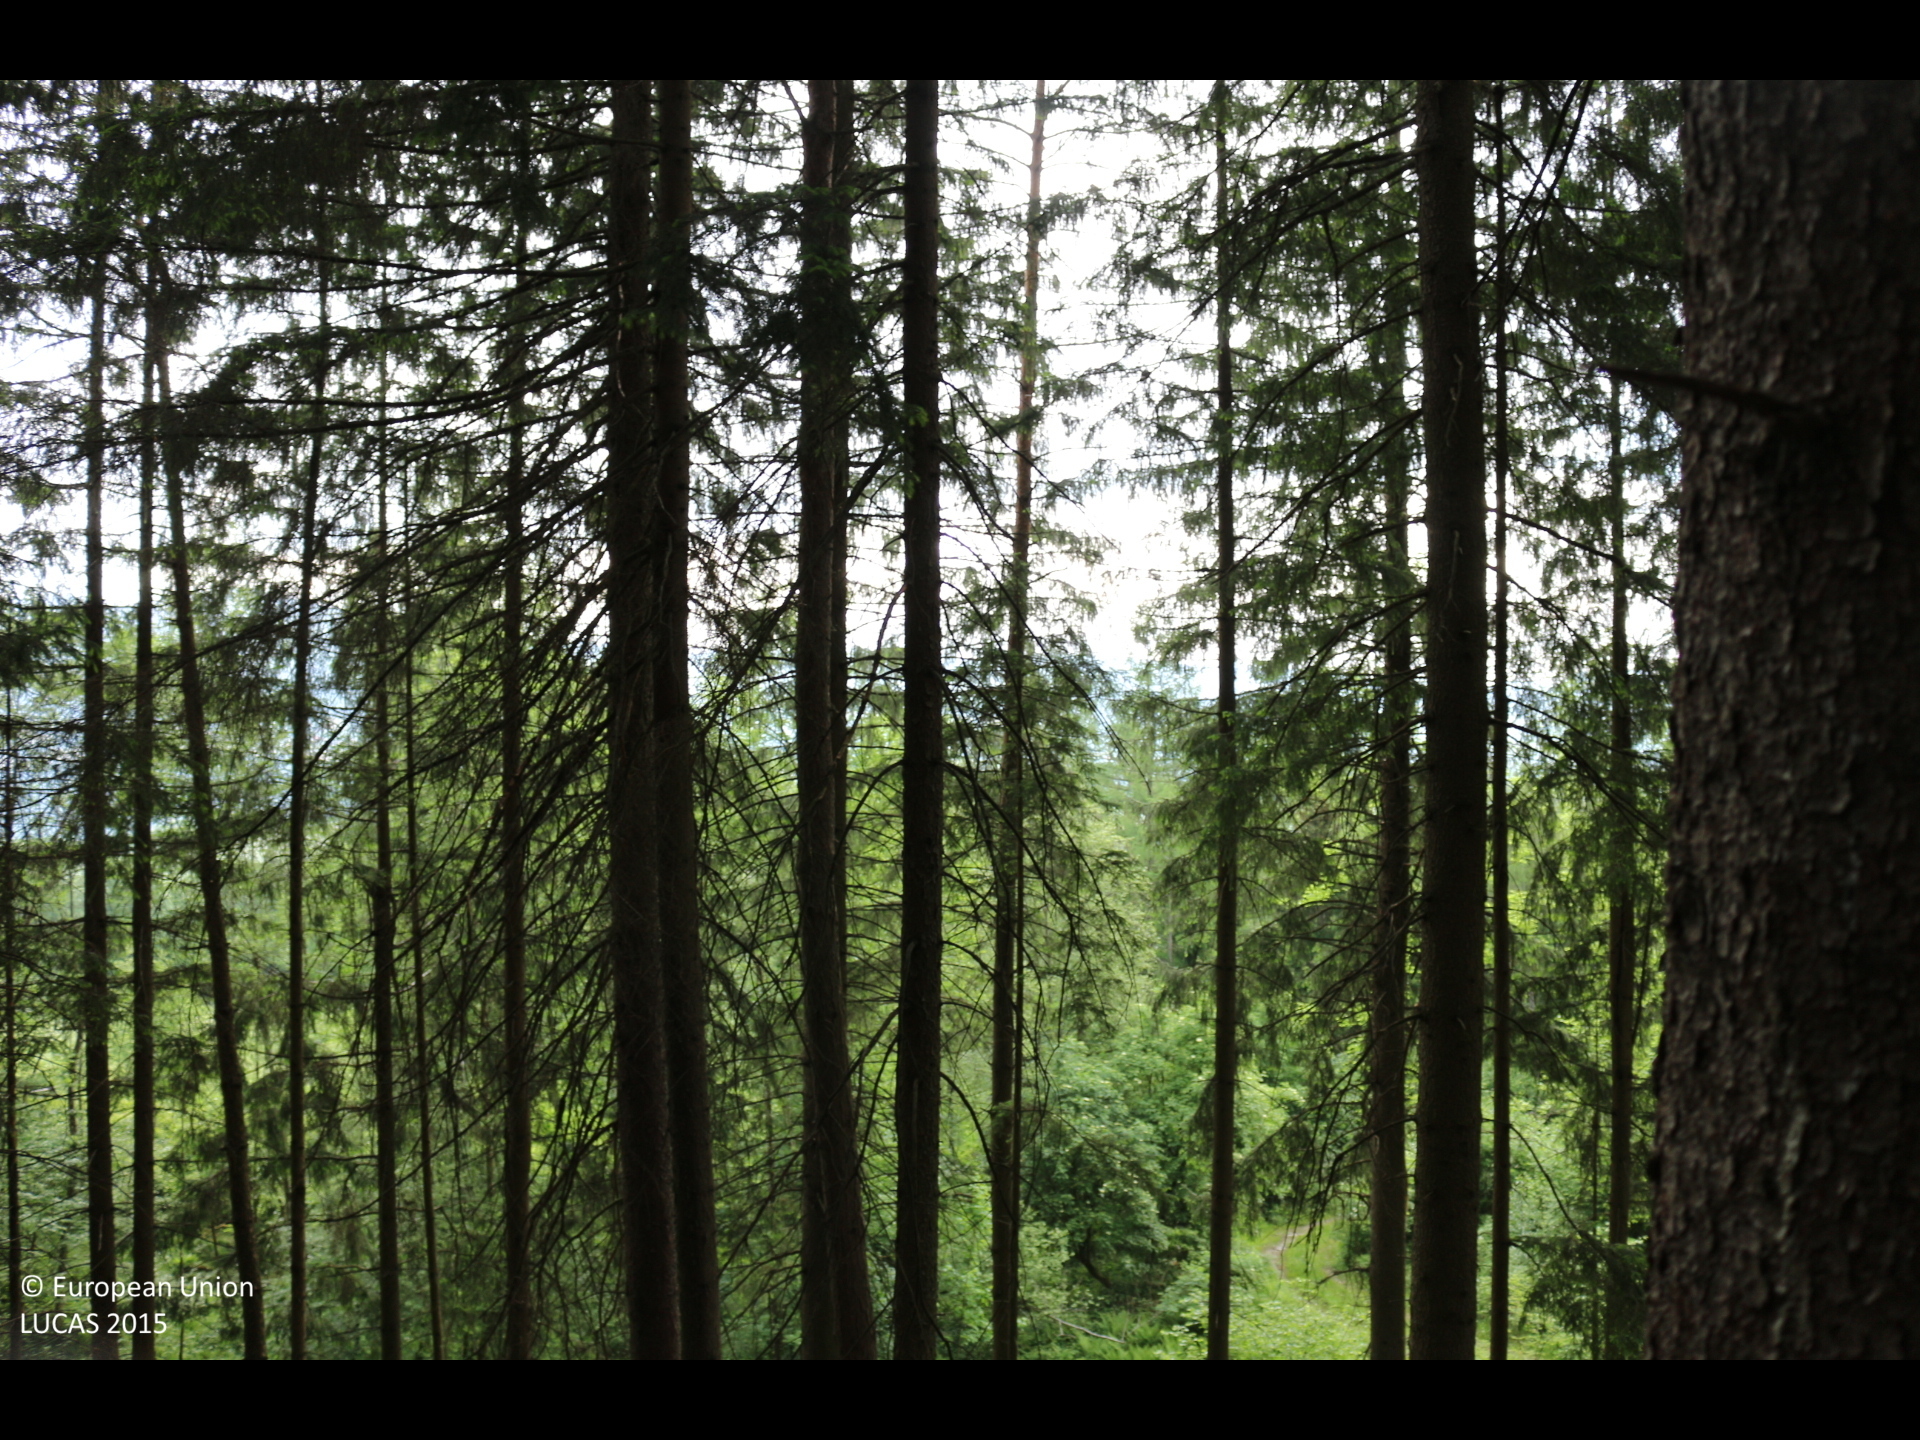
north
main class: Woodland
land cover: Spruce dominated coniferous woodland
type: alpine coniferous forest
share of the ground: > 75 %
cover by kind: coniferous forest trees 100 %
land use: Forestry
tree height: > 5 m
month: May
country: AT
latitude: 46.7007
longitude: 14.2219
